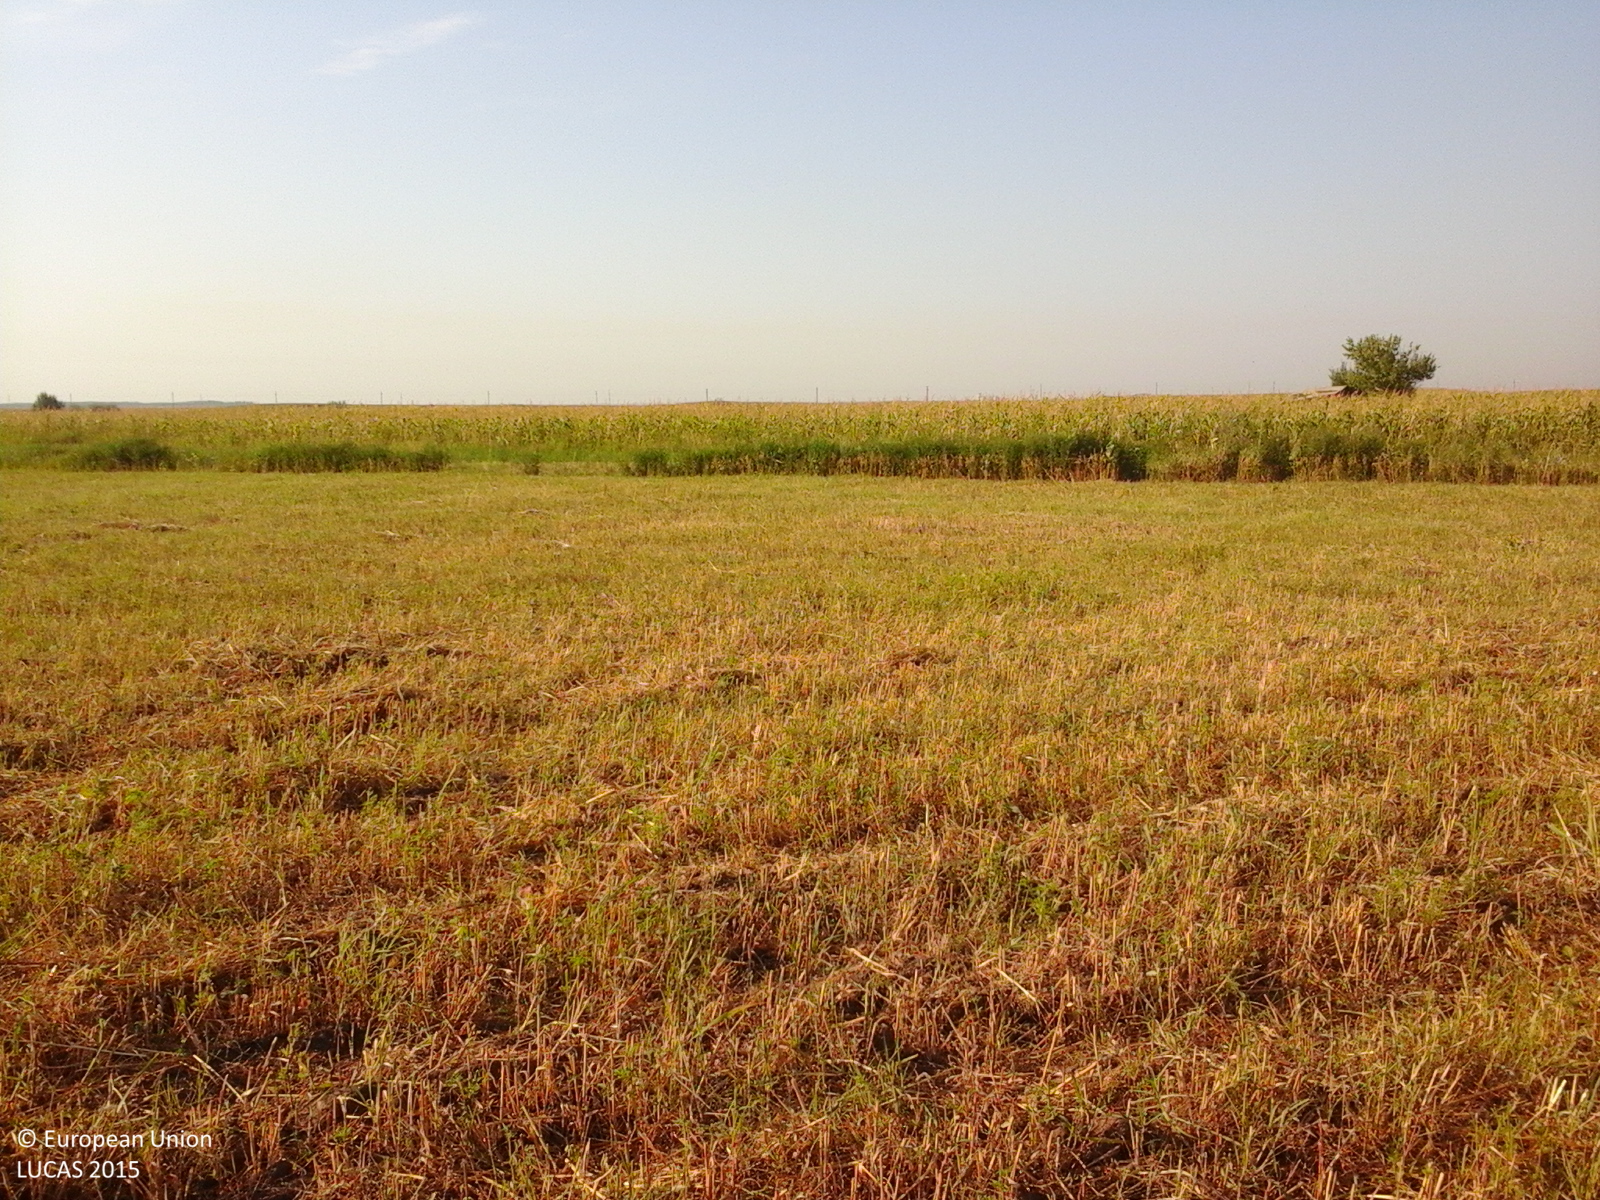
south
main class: Cropland
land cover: Oats
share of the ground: > 75 %
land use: Agriculture (excluding fallow land and kitchen gardens)
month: August
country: RO
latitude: 44.0669
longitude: 23.2168
